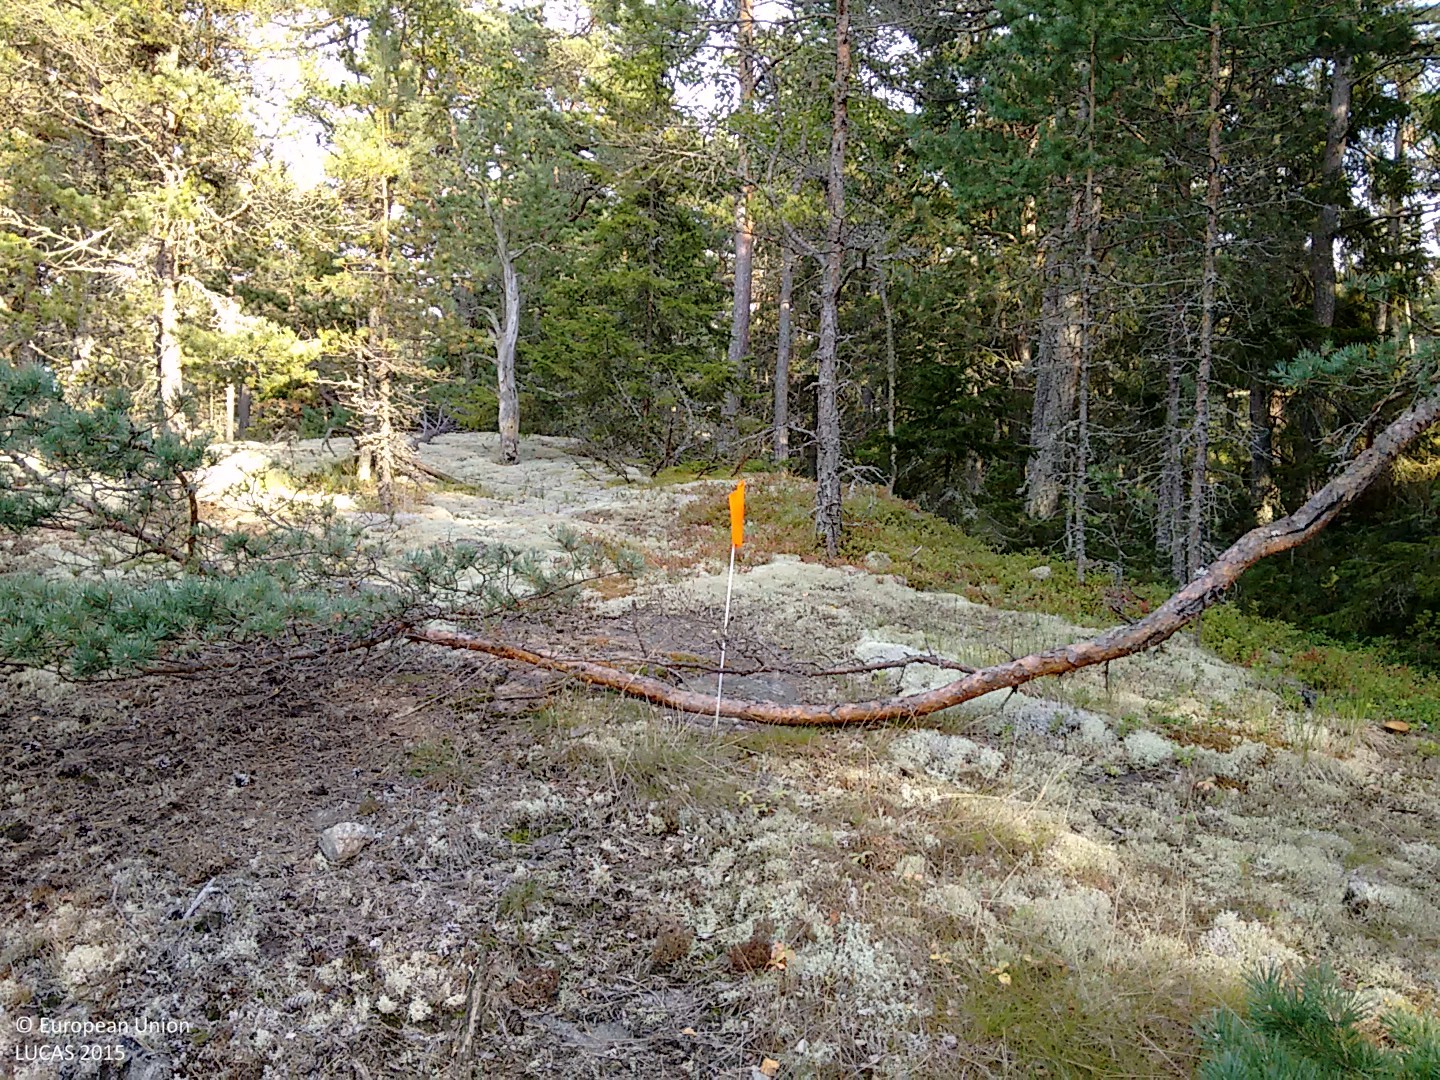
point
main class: Woodland
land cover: Pine dominated coniferous woodland
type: hemiboreal forest and nemoral coniferous forest and mixed broadleaved-coniferous forest
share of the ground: 50 - 75 %
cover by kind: coniferous forest trees 70 %, lichens and mosses 20 %, shrubs 10 %
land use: Forestry
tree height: > 5 m
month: August
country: FI
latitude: 60.0235
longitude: 20.5092
